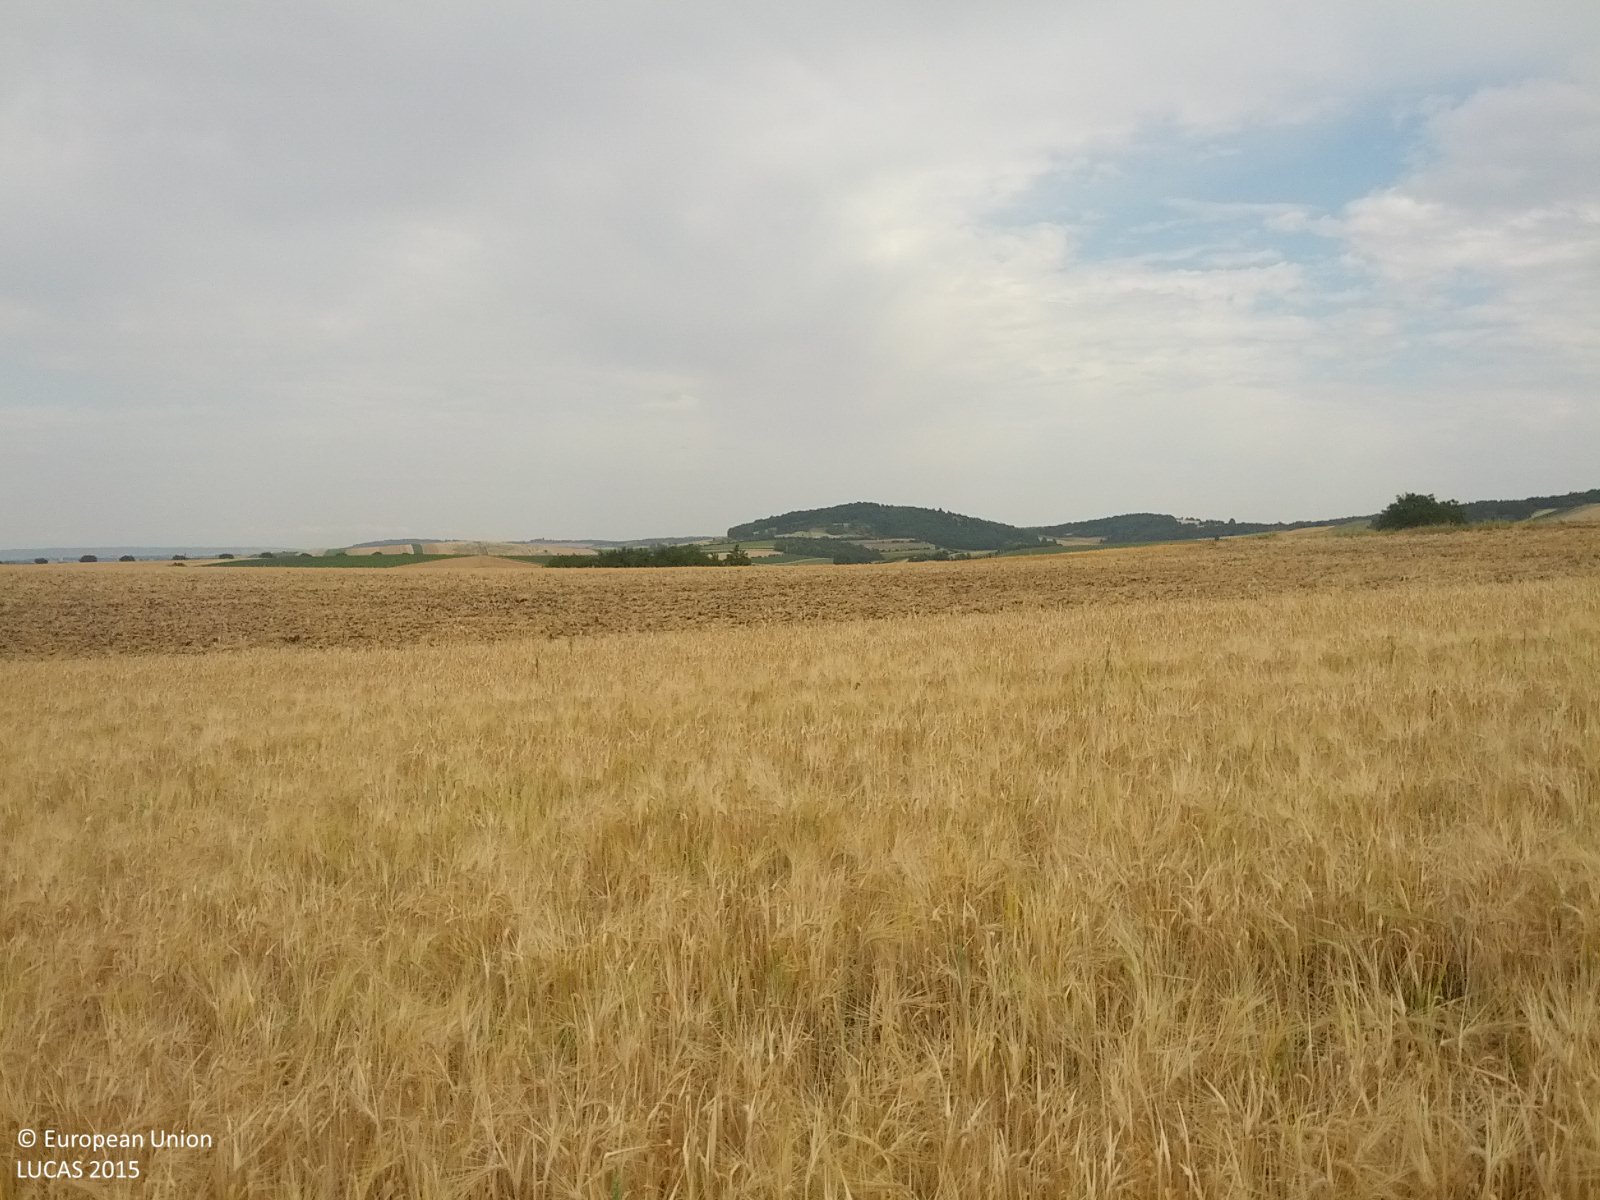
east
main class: Cropland
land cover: Barley
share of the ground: > 75 %
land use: Agriculture (excluding fallow land and kitchen gardens)
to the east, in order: Barley; Other bare soil; Common wheat; Other bare soil; Common wheat; Grass margins; Paved roads, cycling and walking lanes; Grass margins
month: July
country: AT
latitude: 48.6098
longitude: 16.1762
